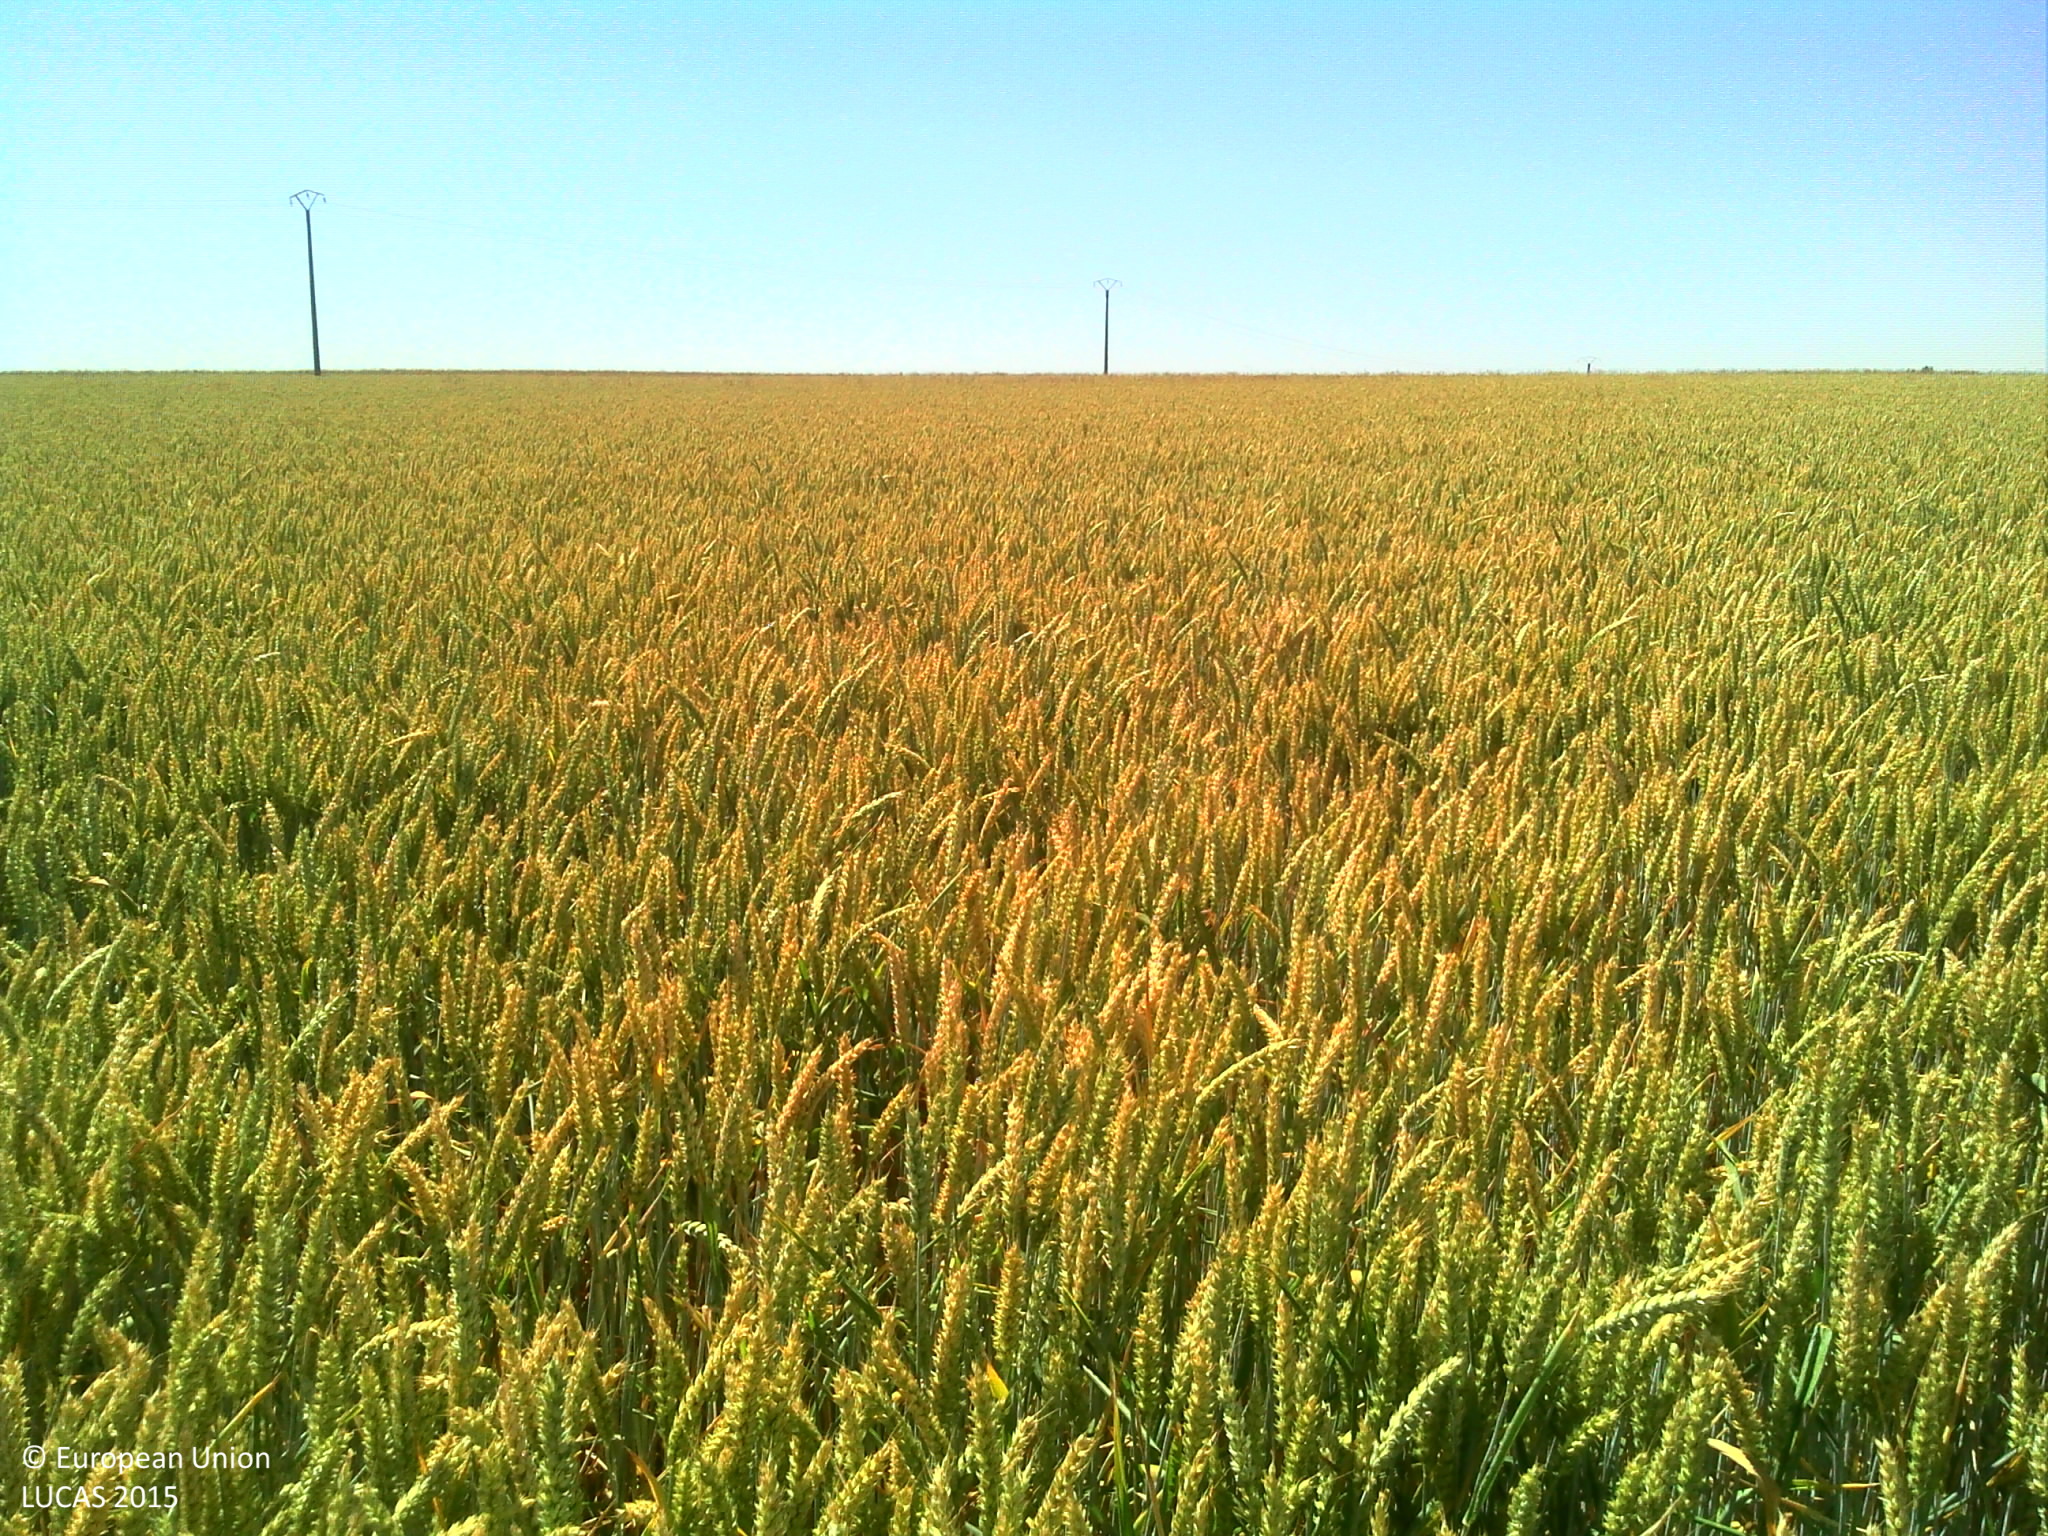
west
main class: Cropland
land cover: Common wheat
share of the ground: > 75 %
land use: Agriculture (excluding fallow land and kitchen gardens)
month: June
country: FR
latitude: 48.9641
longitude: 3.3956
